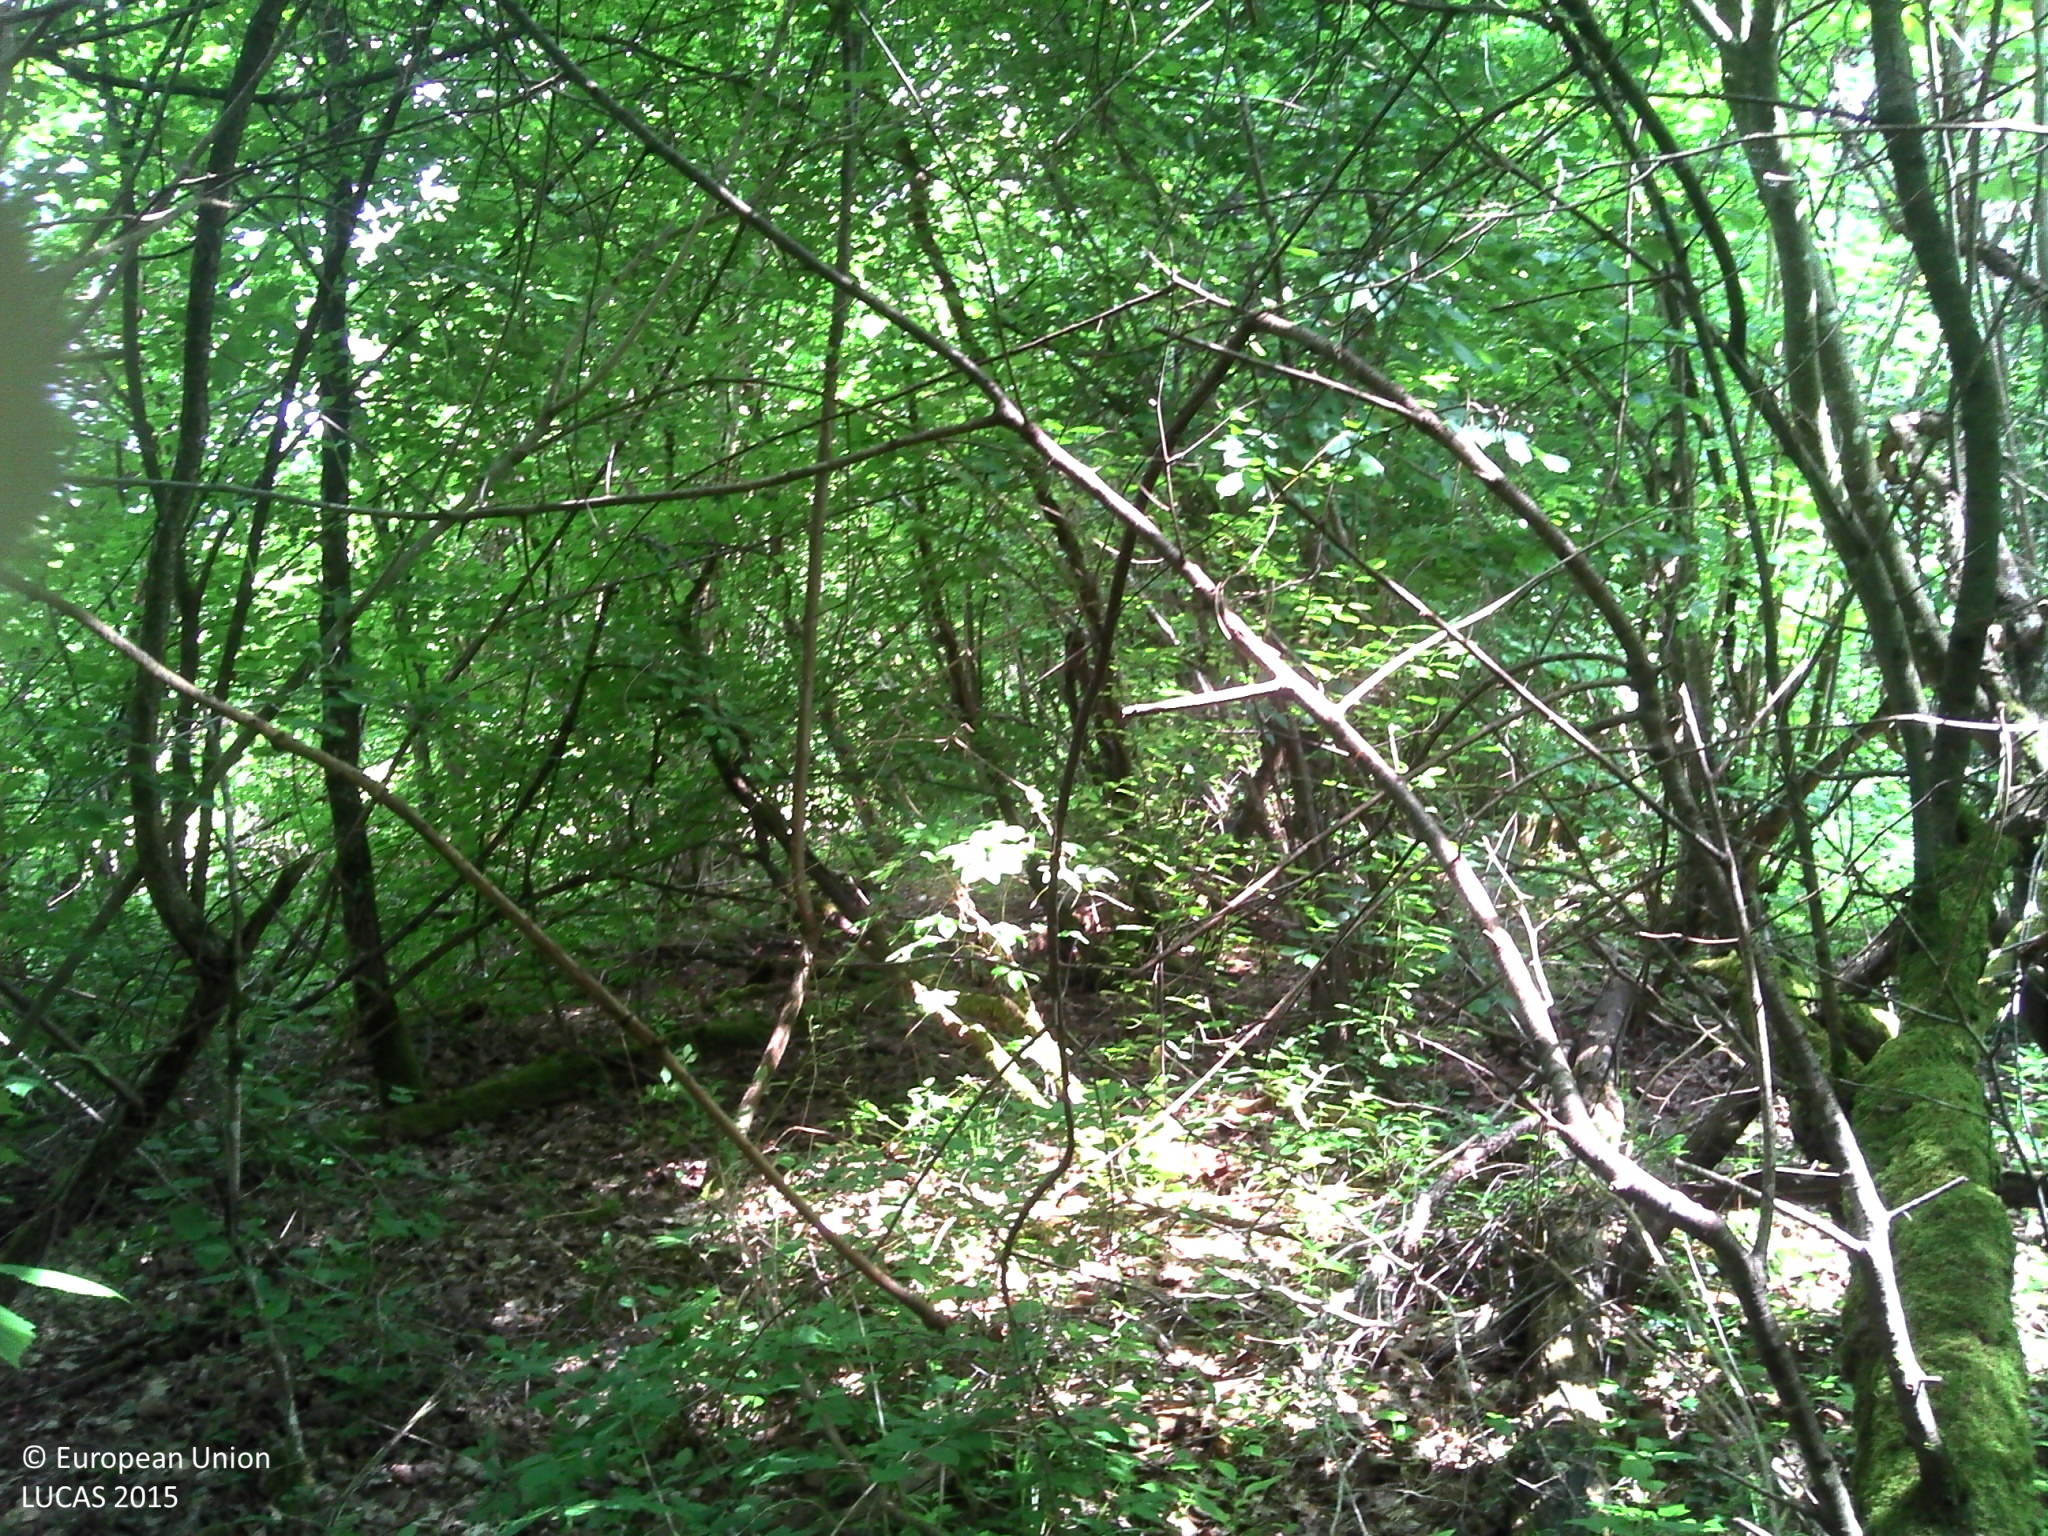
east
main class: Woodland
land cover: Broadleaved woodland
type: acidophilous oak and oak-birch forest
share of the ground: > 75 %
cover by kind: broadleaved forest trees 70 %, coniferous forest trees 20 %, herbaceous plants 5 %, lichens and mosses 5 %
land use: Semi-natural and natural areas not in use
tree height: > 5 m
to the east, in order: Broadleaved woodland; Grass margins; Vineyards; Grassland without tree/shrub cover; Broadleaved woodland; Grass margins; Common wheat
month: May
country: FR
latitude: 47.7629
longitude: 3.8462
